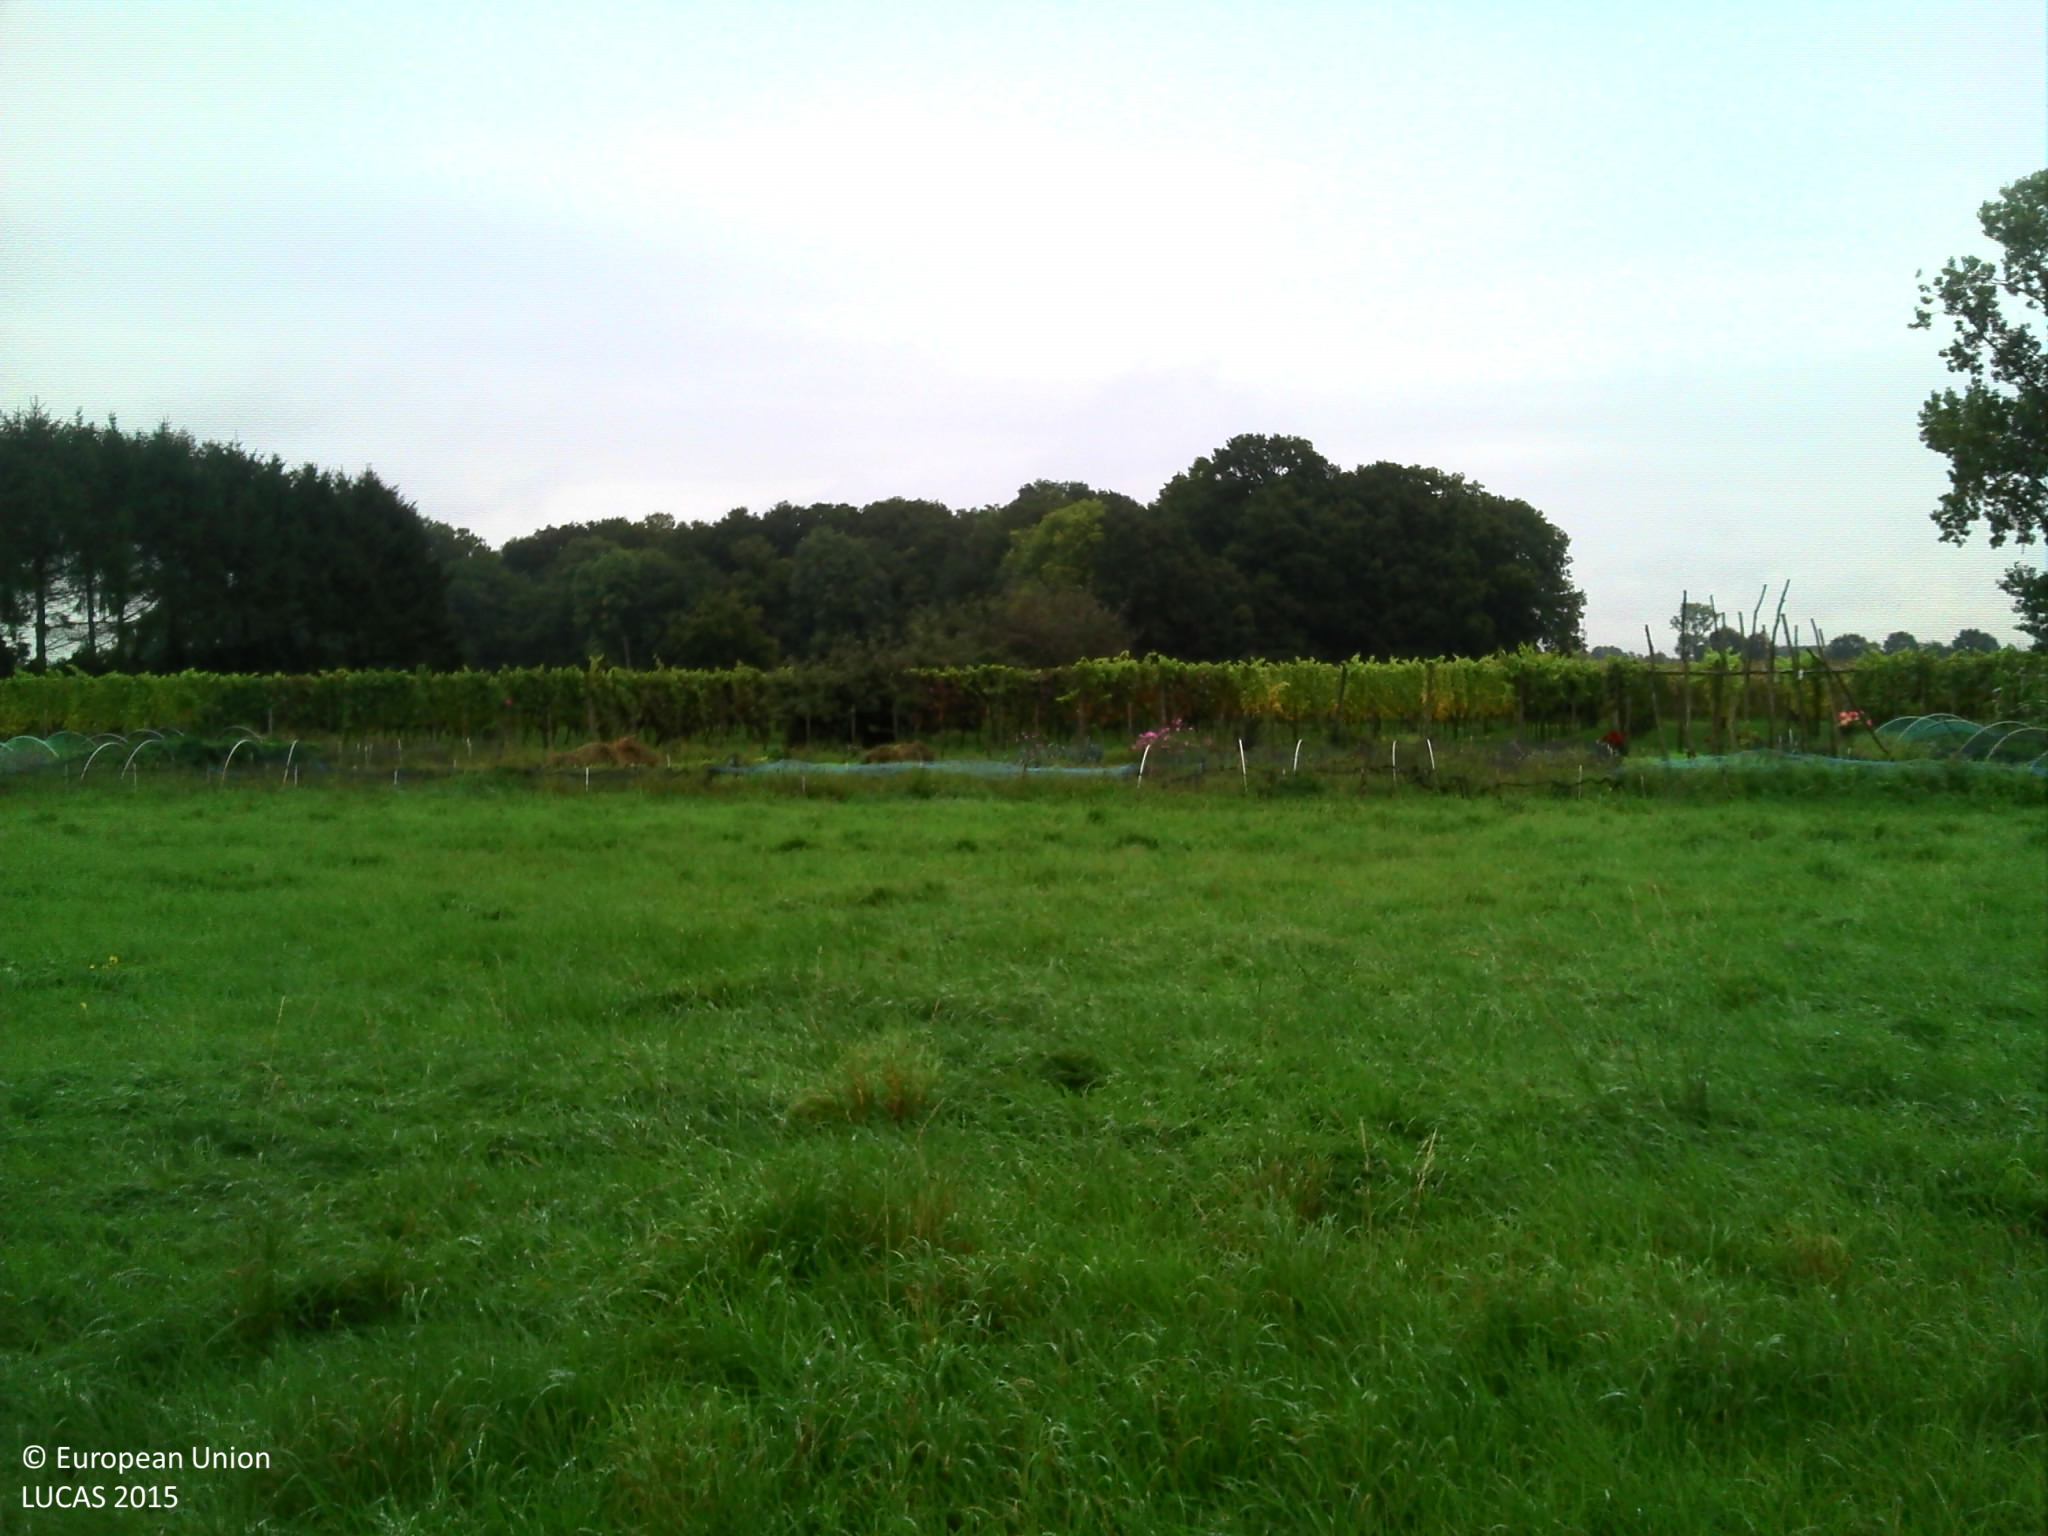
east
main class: Grassland
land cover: Grassland without tree/shrub cover
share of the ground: > 75 %
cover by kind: herbaceous plants 100 %
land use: Agriculture (excluding fallow land and kitchen gardens)
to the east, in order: Grassland without tree/shrub cover; Fences; Grass margins; Ditches and canals; Abandoned hedges; Temporary grasslands; Other fresh vegetables; Spontaneously vegetated surfaces; Other fresh vegetables; Grass margins; Tracks; Vineyards; Grassland without tree/shrub cover; Maize; Broadleaved woodland
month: October
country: BE
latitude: 51.1291
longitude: 4.8095
